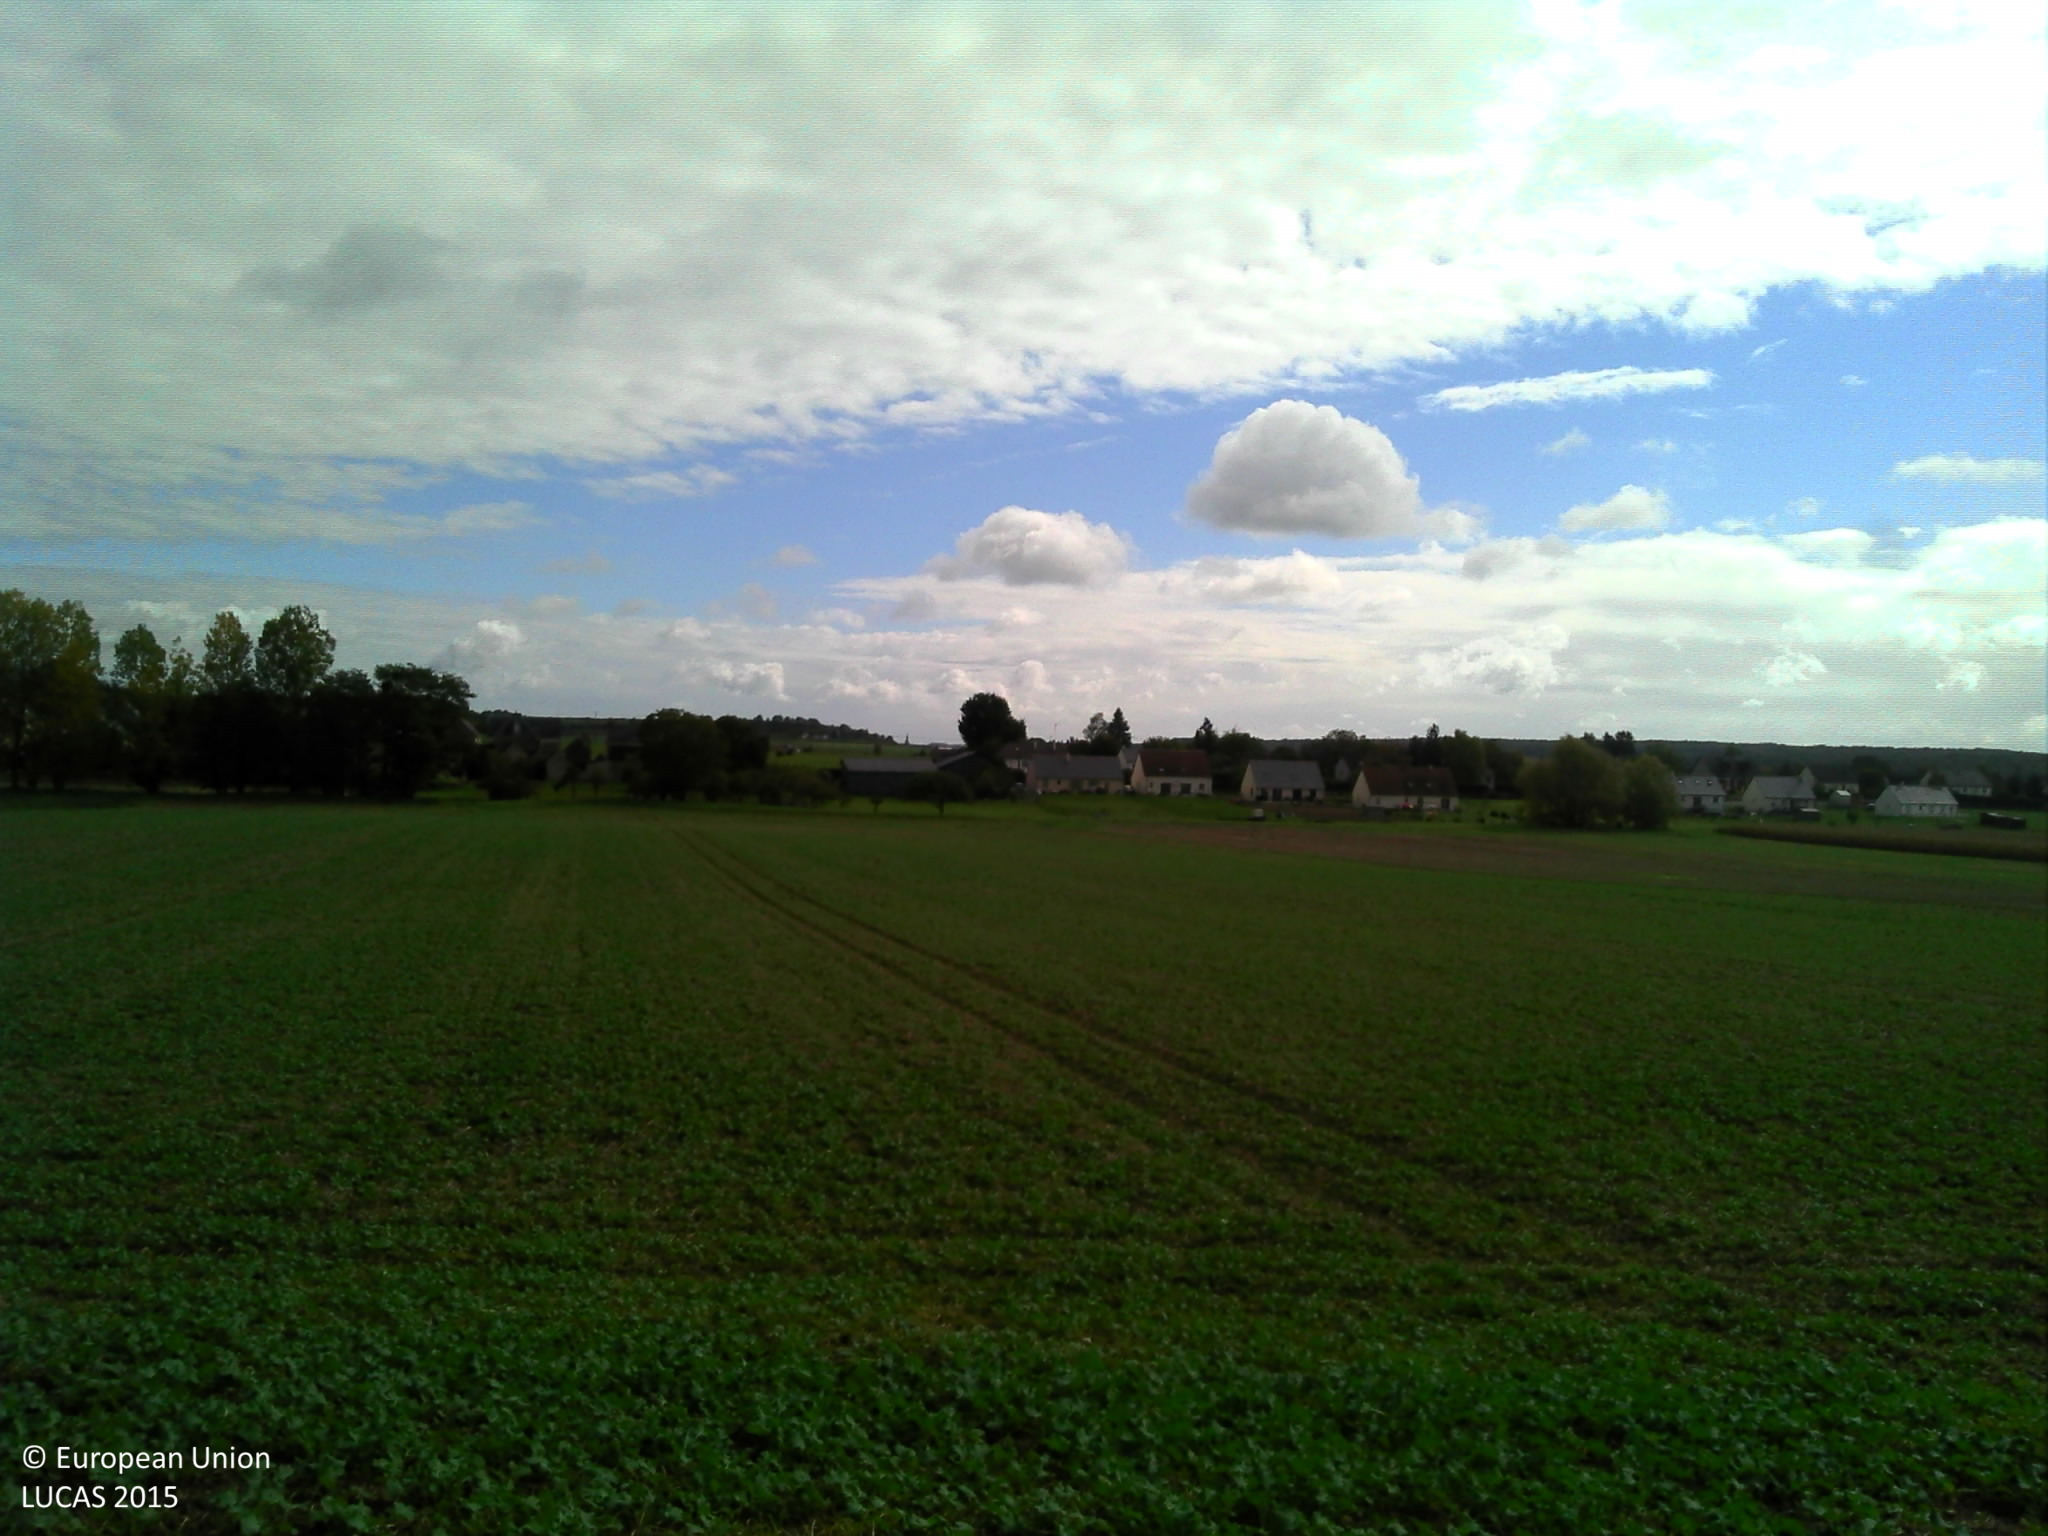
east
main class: Cropland
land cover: Other fibre and oleaginous crops
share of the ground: > 75 %
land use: Agriculture (excluding fallow land and kitchen gardens)
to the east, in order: Other fibre and oleaginous crops; Tracks; Common wheat; Grassland without tree/shrub cover; Rivers and streams; Broadleaved woodland; Grassland without tree/shrub cover
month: October
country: FR
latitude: 47.1551
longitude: 0.4436
